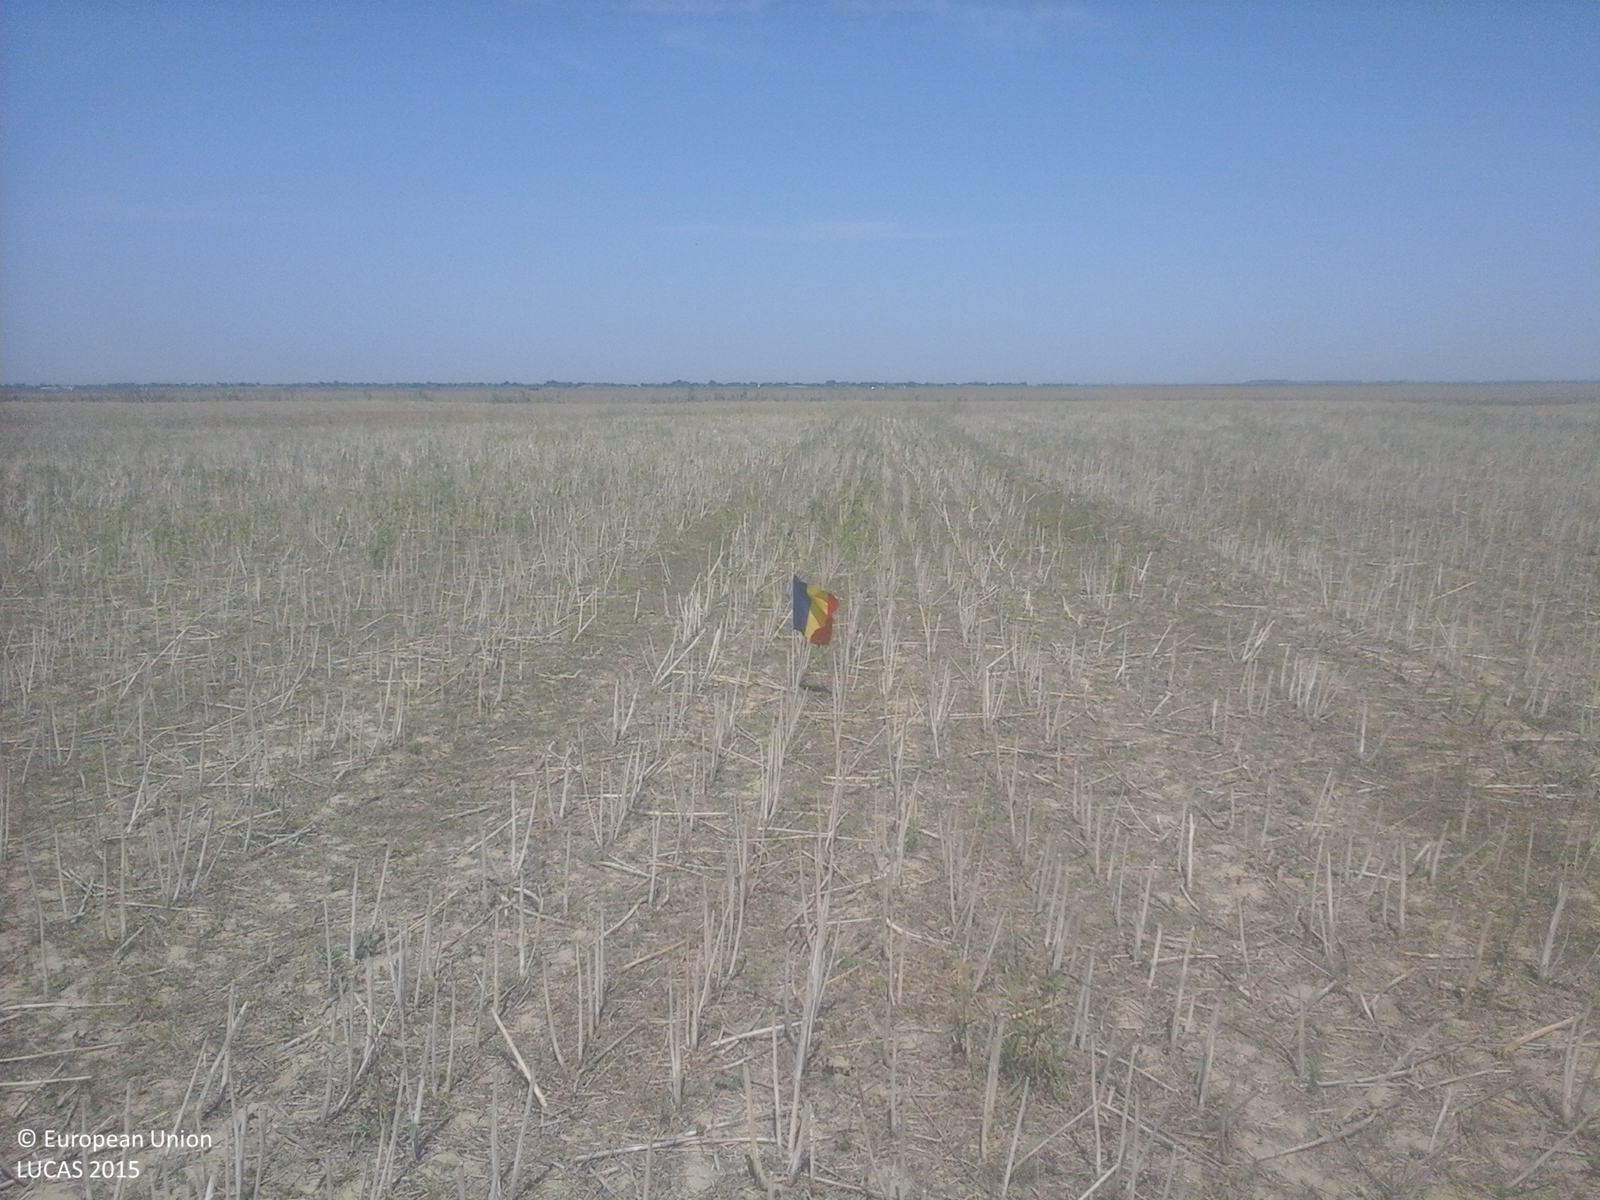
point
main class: Cropland
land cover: Rape and turnip rape
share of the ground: 25 - 50 %
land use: Agriculture (excluding fallow land and kitchen gardens)
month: August
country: RO
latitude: 45.5325
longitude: 27.4256
